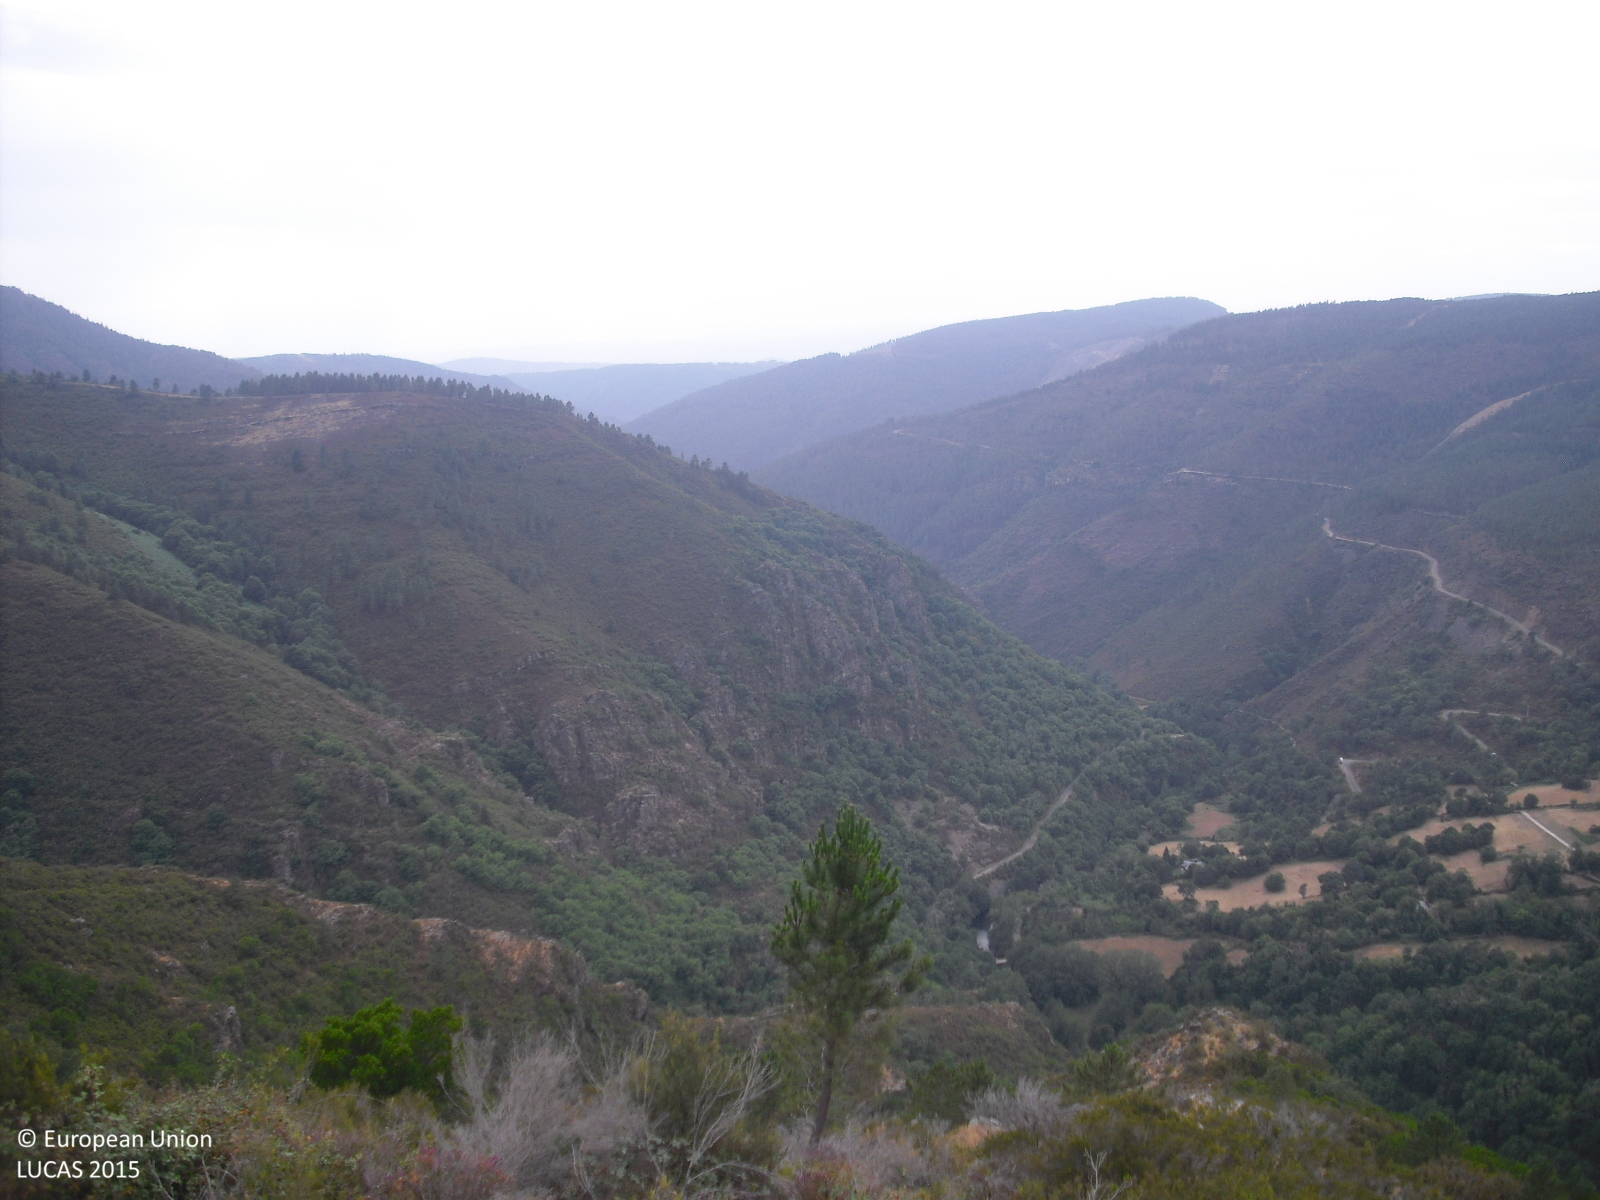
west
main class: Woodland
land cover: Pine dominated mixed woodland
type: hemiboreal forest and nemoral coniferous forest and mixed broadleaved-coniferous forest
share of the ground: 25 - 50 %
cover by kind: broadleaved forest trees 50 %, coniferous forest trees 30 %, consolidated bare surface 20 %
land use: Semi-natural and natural areas not in use
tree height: > 5 m
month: July
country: ES
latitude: 42.5435
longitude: -7.2446
